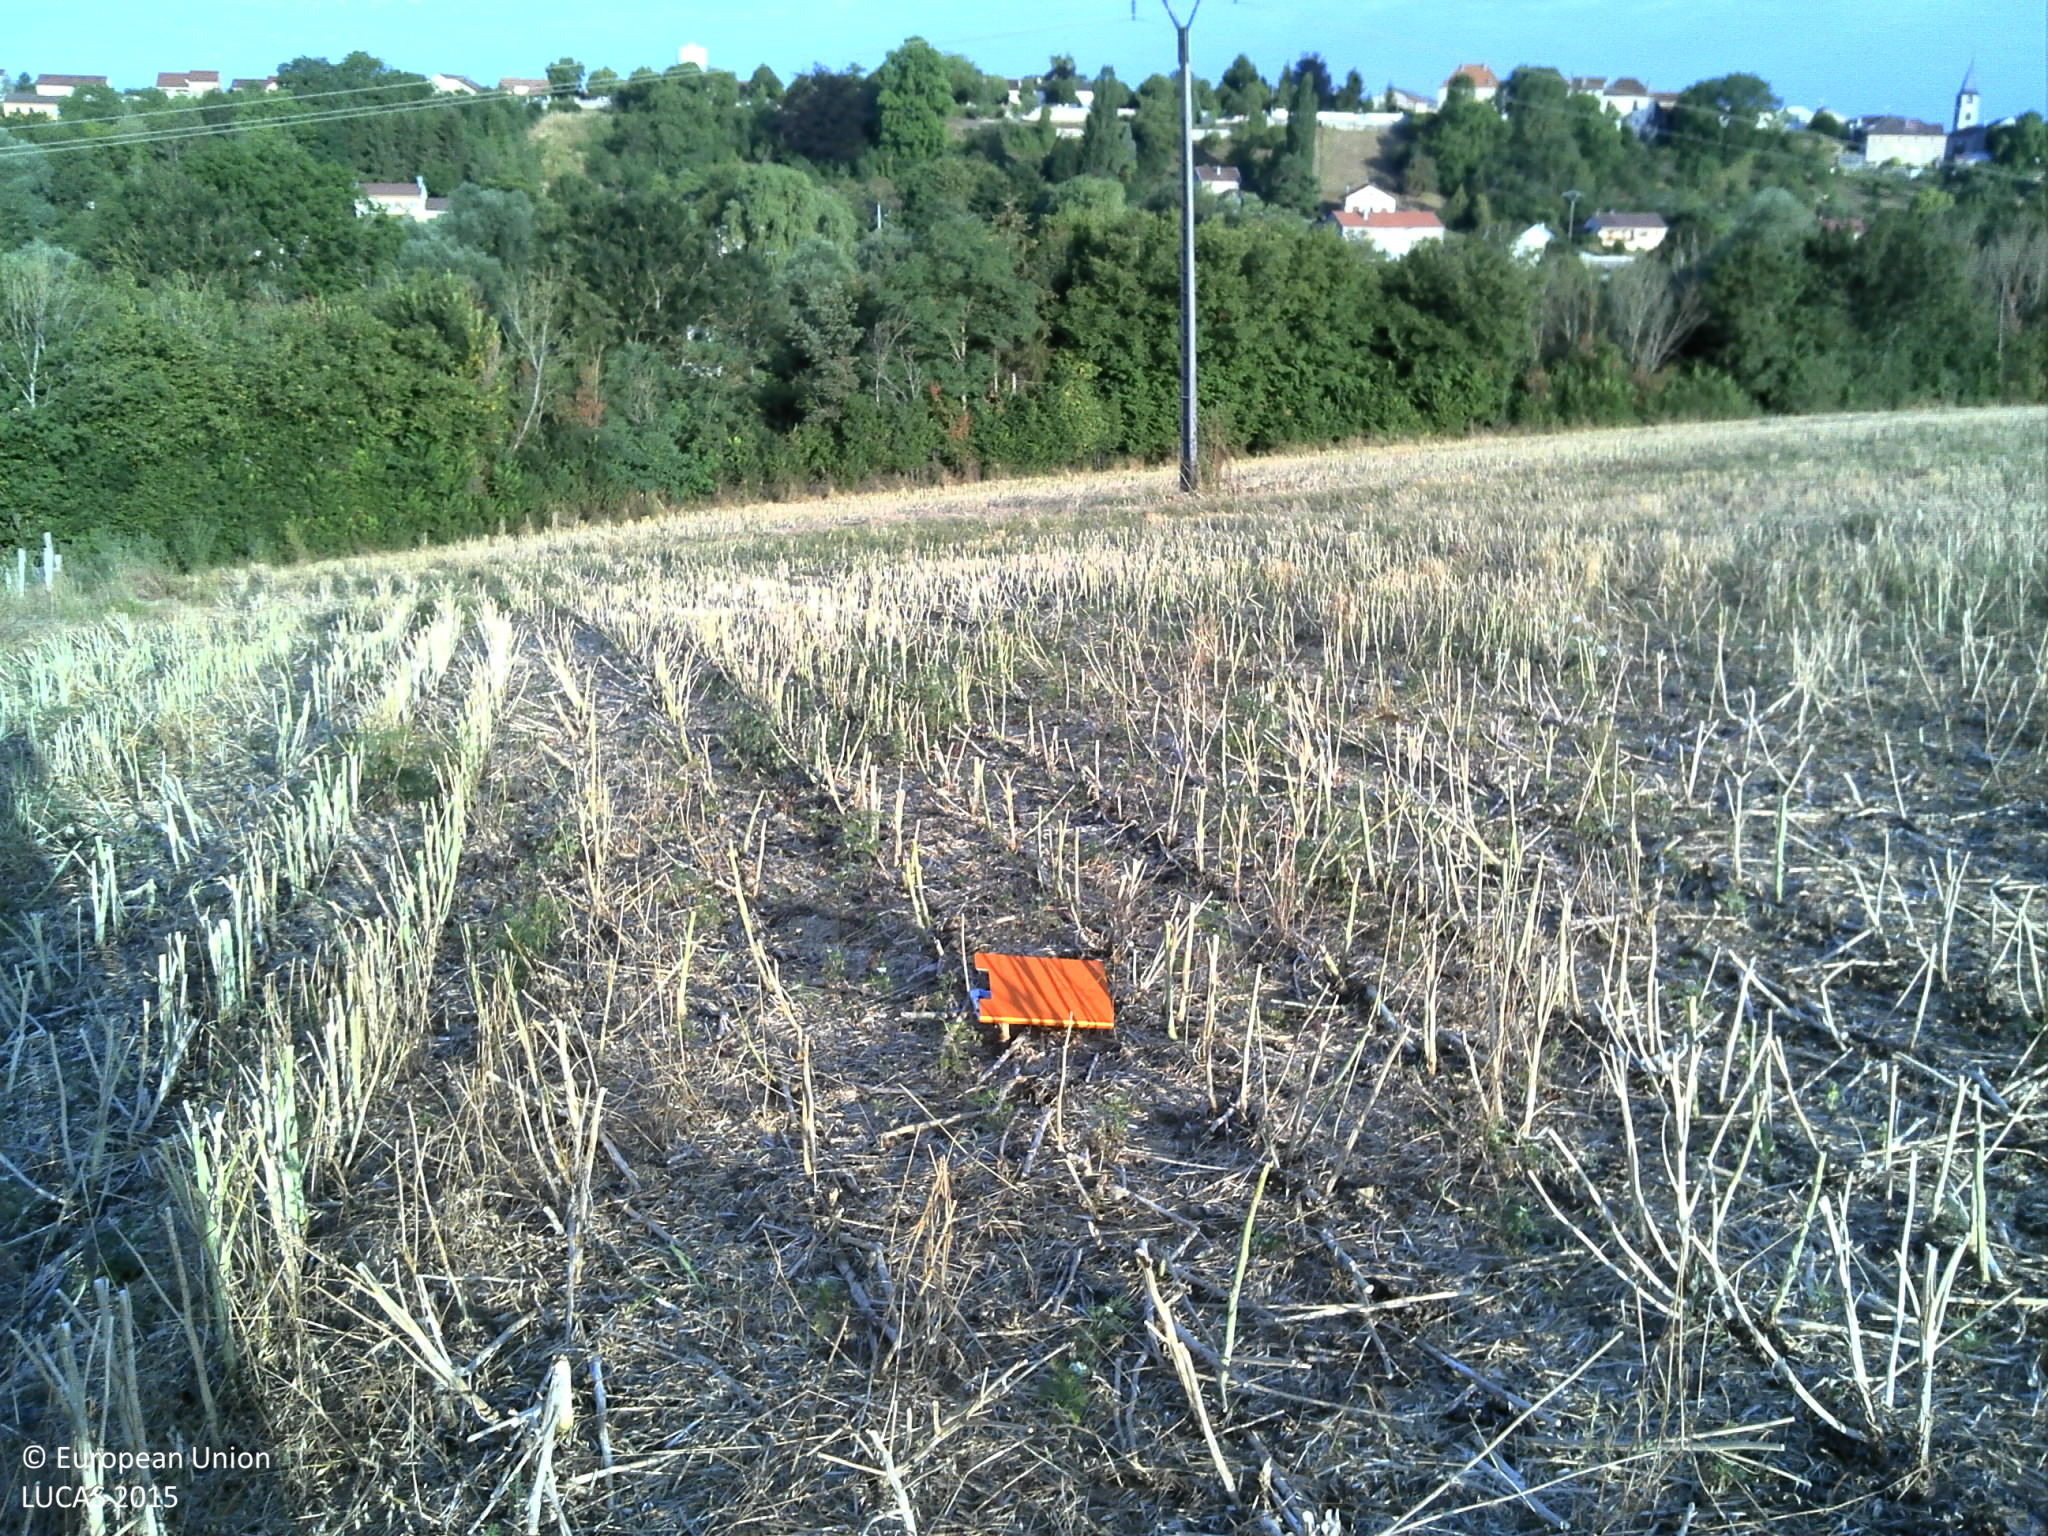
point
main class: Cropland
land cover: Rape and turnip rape
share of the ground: < 10 %
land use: Agriculture (excluding fallow land and kitchen gardens)
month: July
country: FR
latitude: 48.3178
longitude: 6.1300
